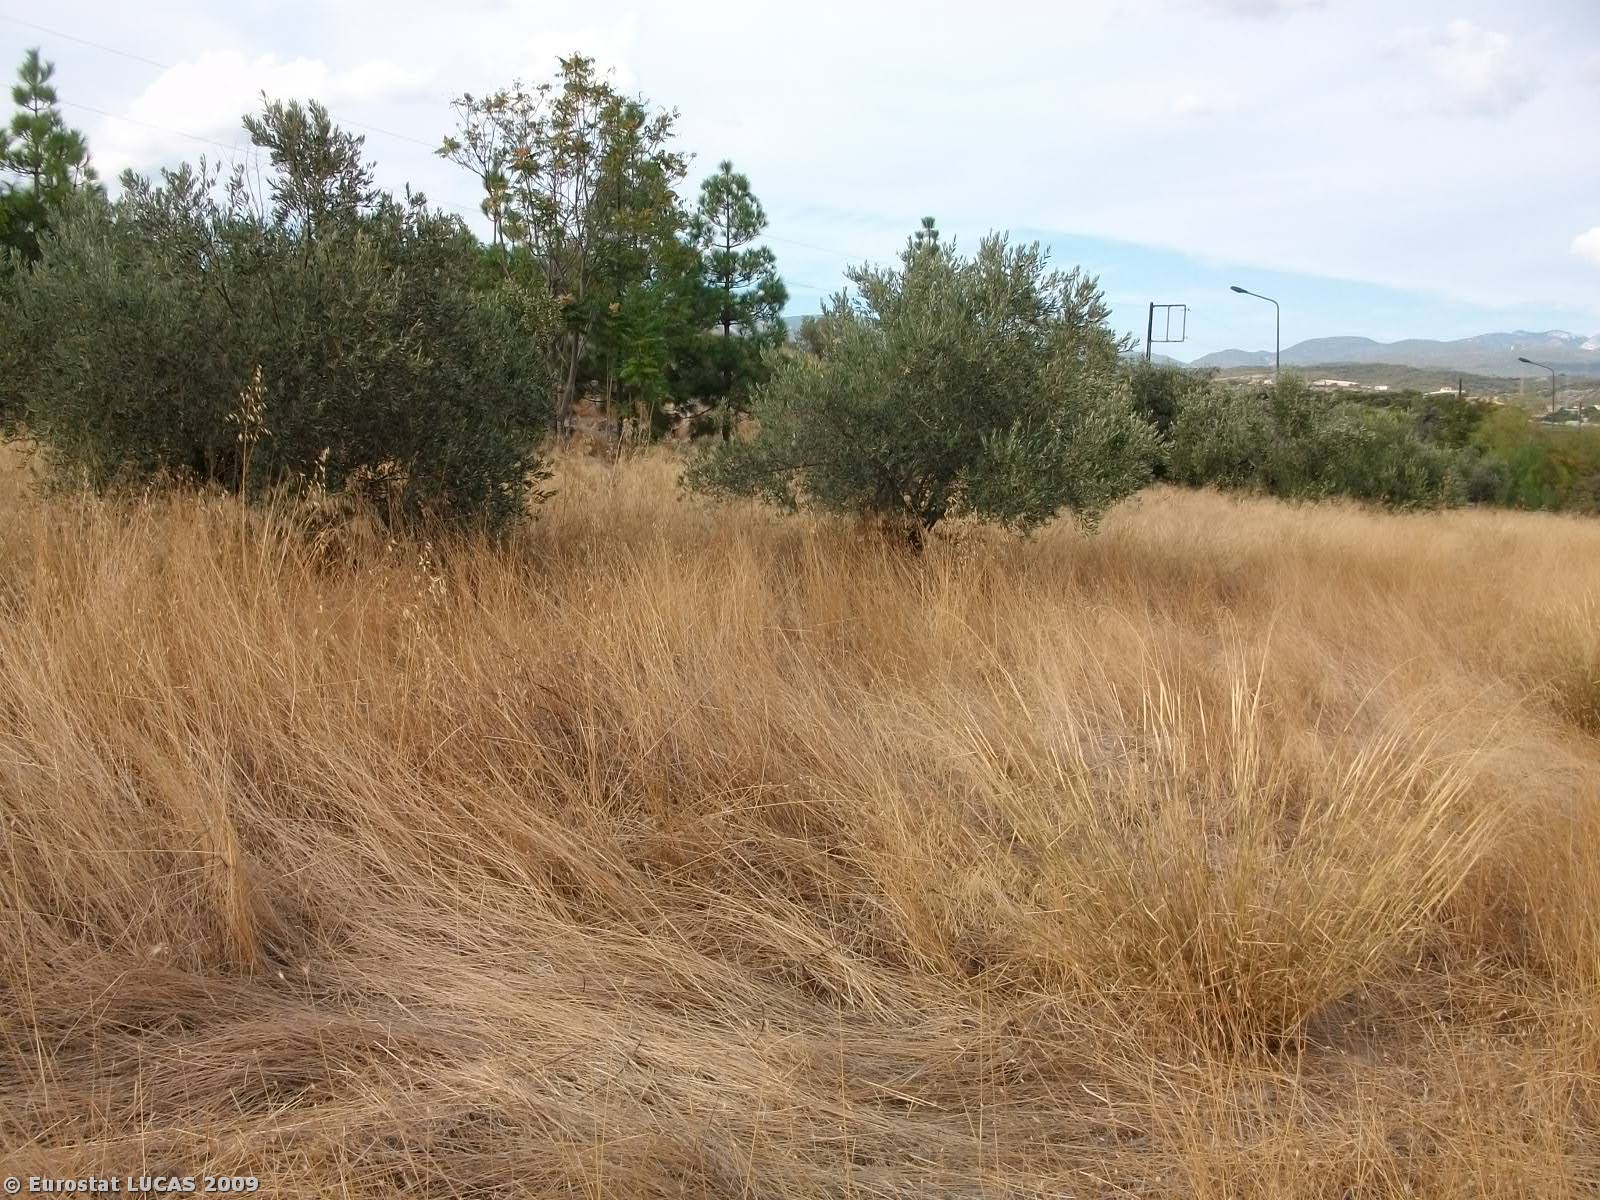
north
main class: Grassland
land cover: Spontaneously vegetated surfaces
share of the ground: > 75 %
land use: Fallow land
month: September
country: GR
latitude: 37.9152
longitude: 22.9966
